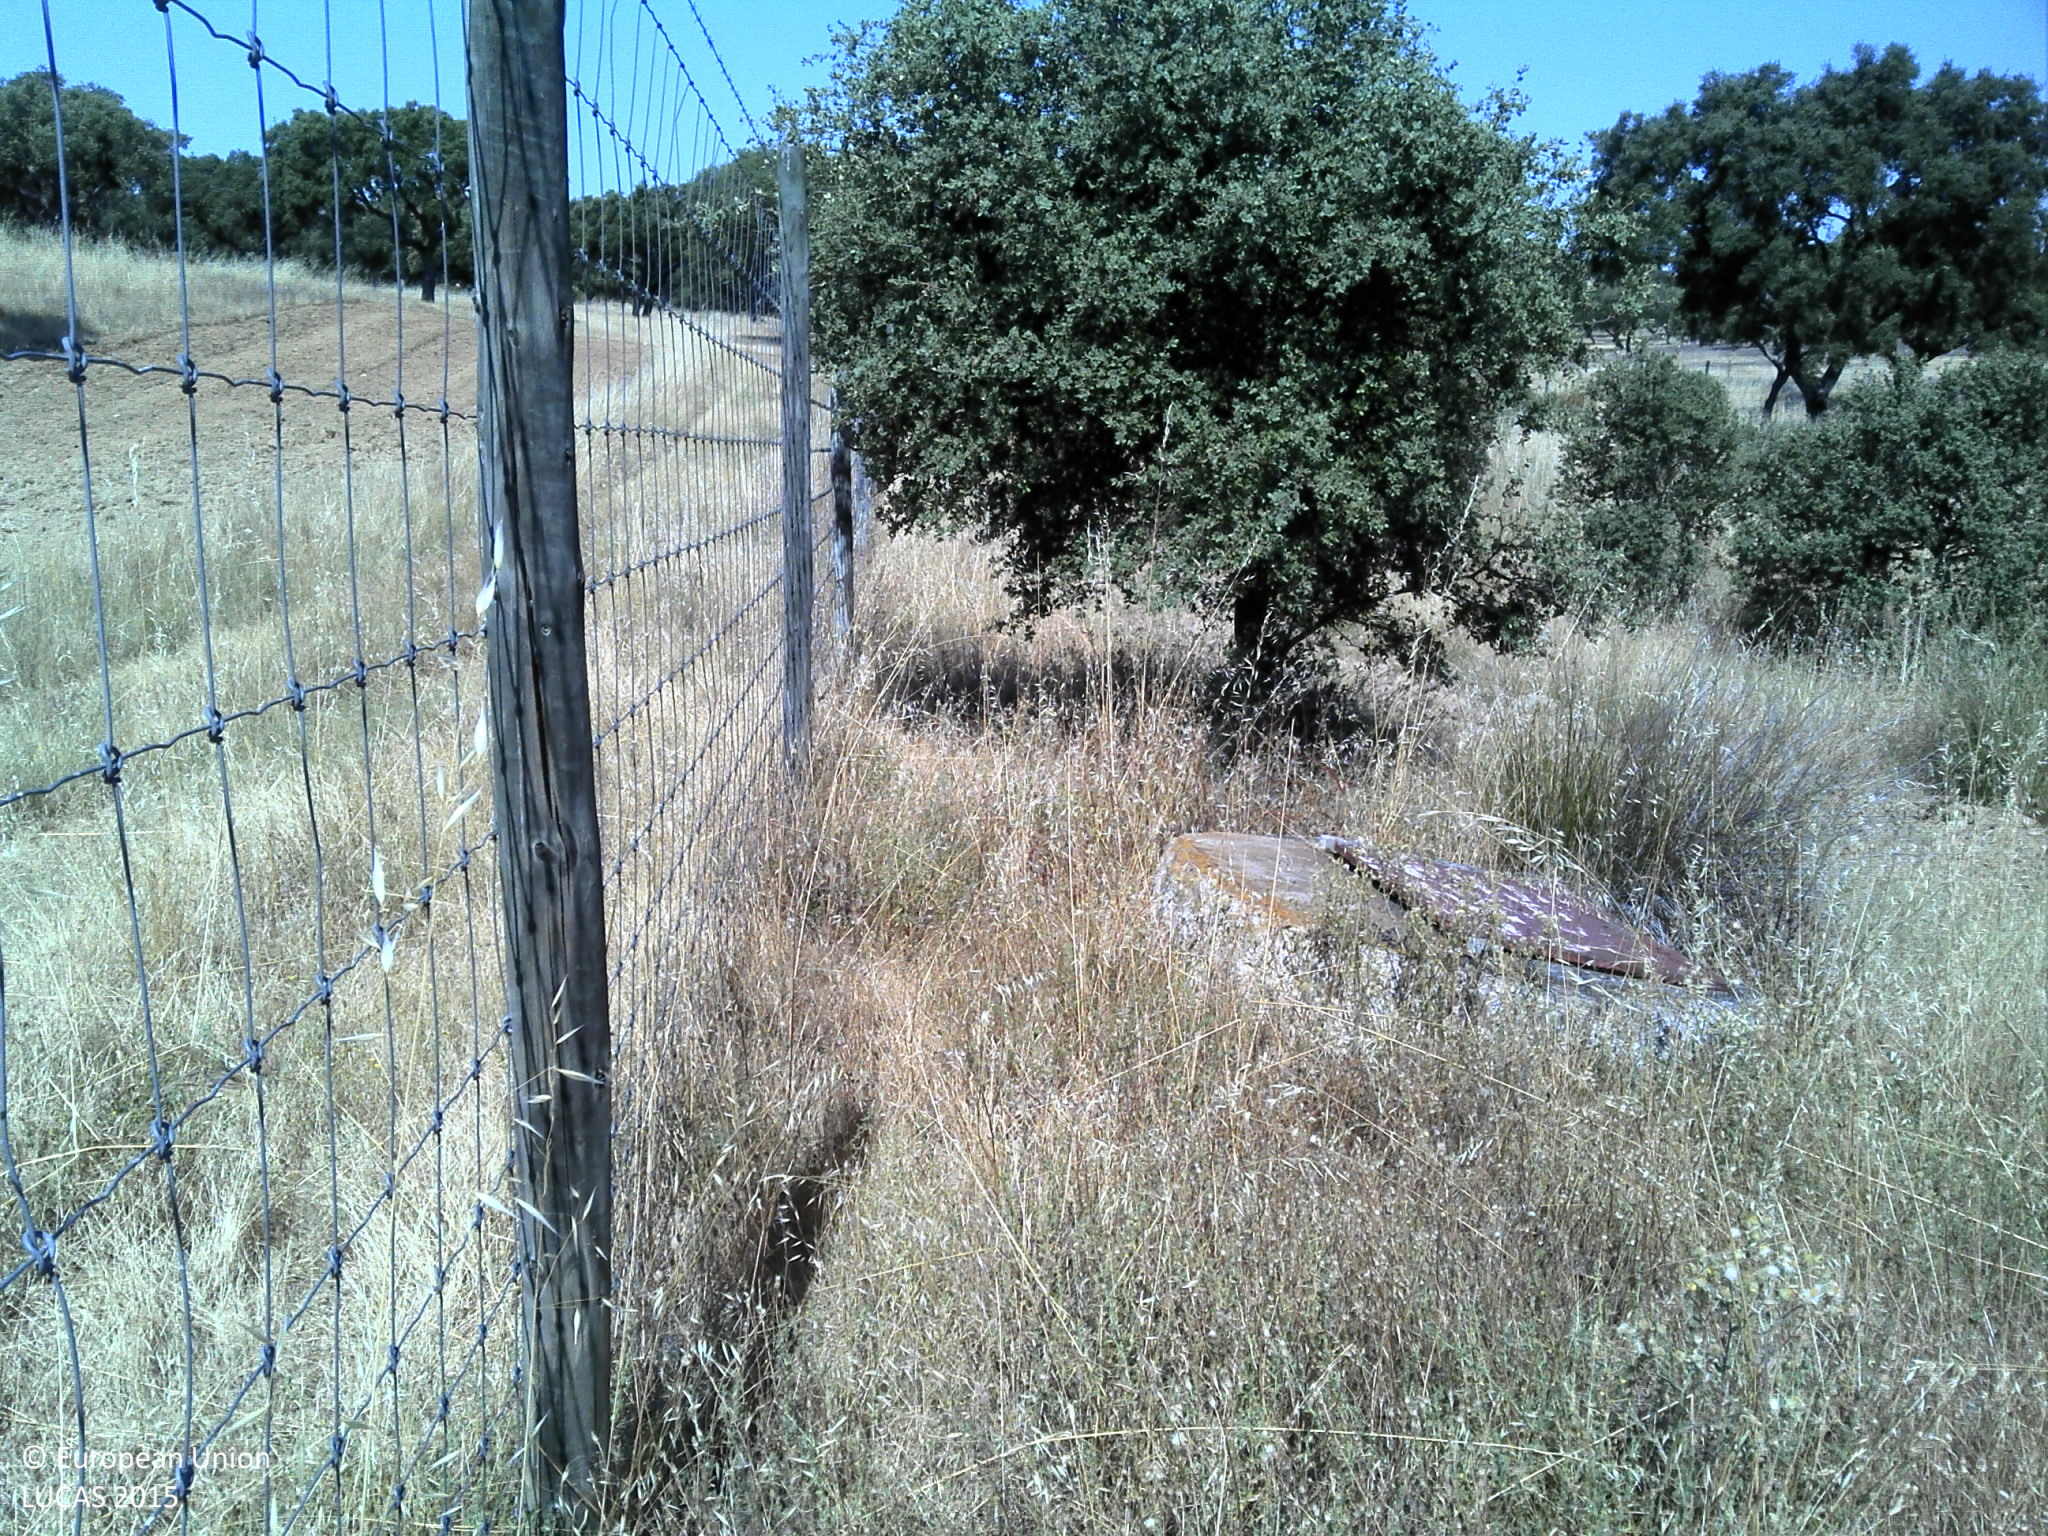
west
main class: Grassland
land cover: Grassland with sparse tree/shrub cover
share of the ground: < 10 %
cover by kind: herbaceous plants 85 %, unconsolidated bare surface 10 %, broadleaved forest trees 5 %
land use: Agriculture (excluding fallow land and kitchen gardens)
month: June
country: PT
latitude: 37.7000
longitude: -7.6068
